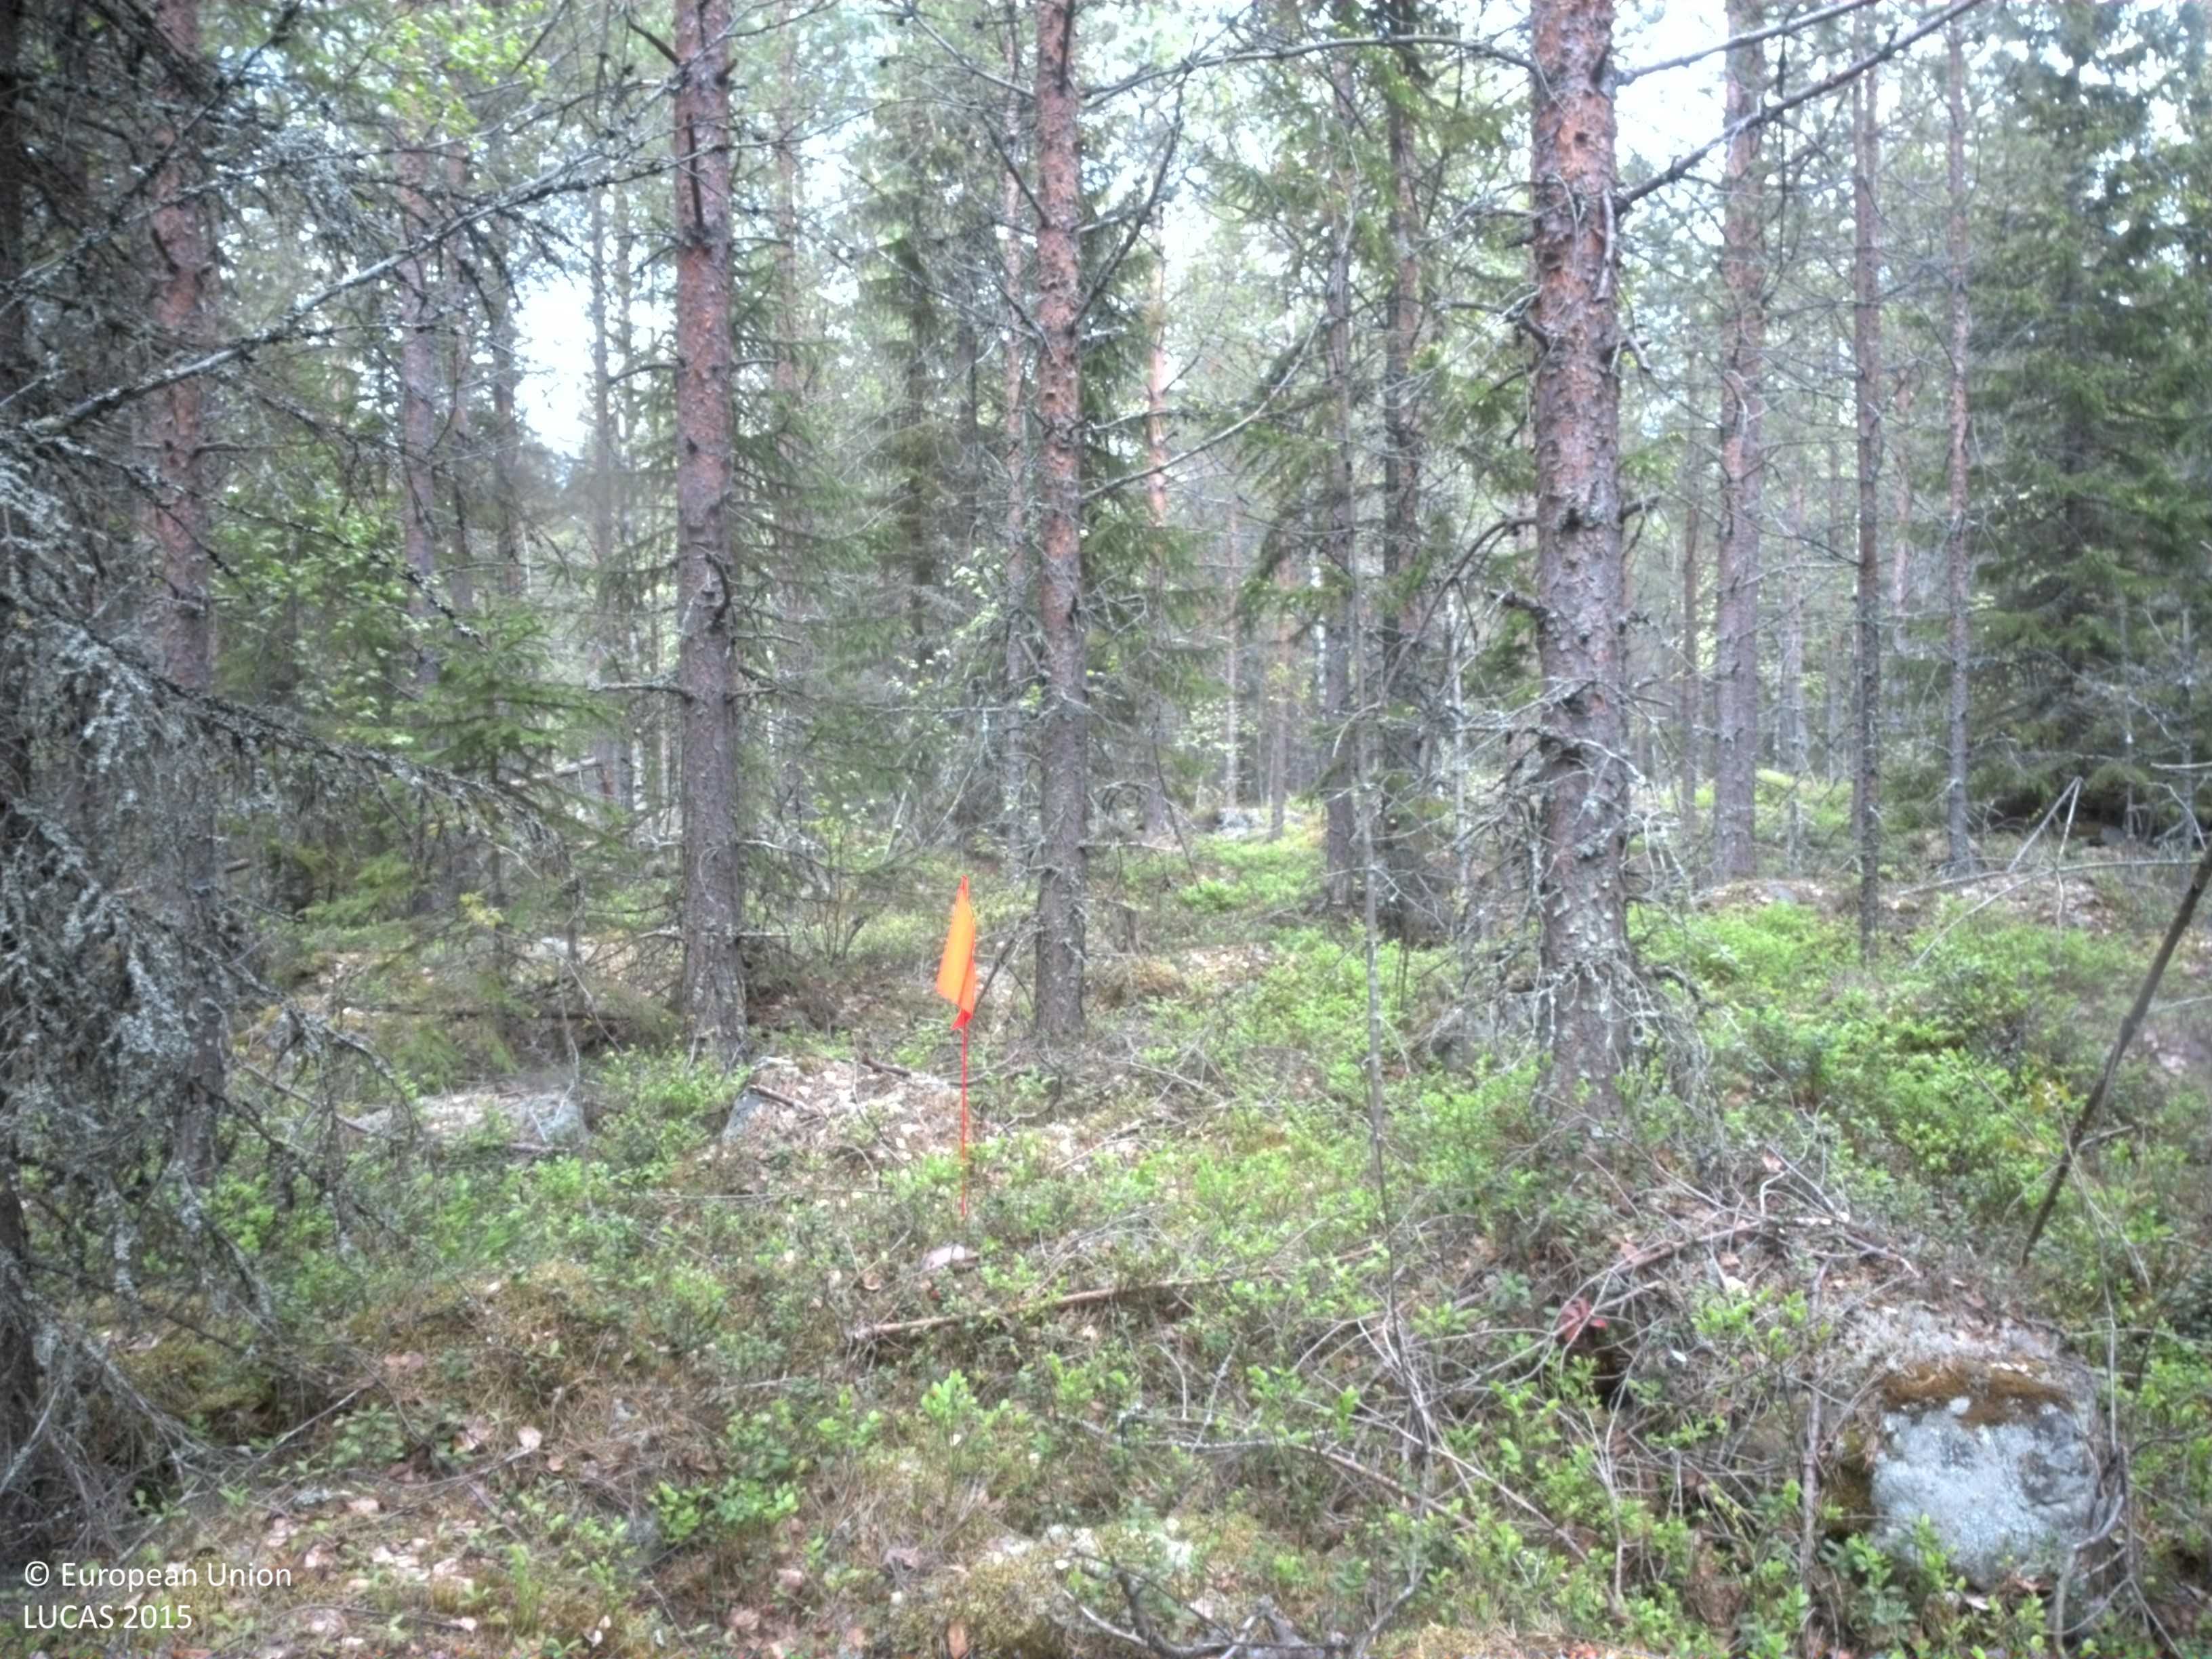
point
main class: Woodland
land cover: Pine dominated coniferous woodland
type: boreal forest
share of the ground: 50 - 75 %
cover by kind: coniferous forest trees 65 %, shrubs 20 %, broadleaved forest trees 10 %, lichens and mosses 5 %
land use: Forestry
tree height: > 5 m
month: June
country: SE
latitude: 63.9652
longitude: 20.6633
